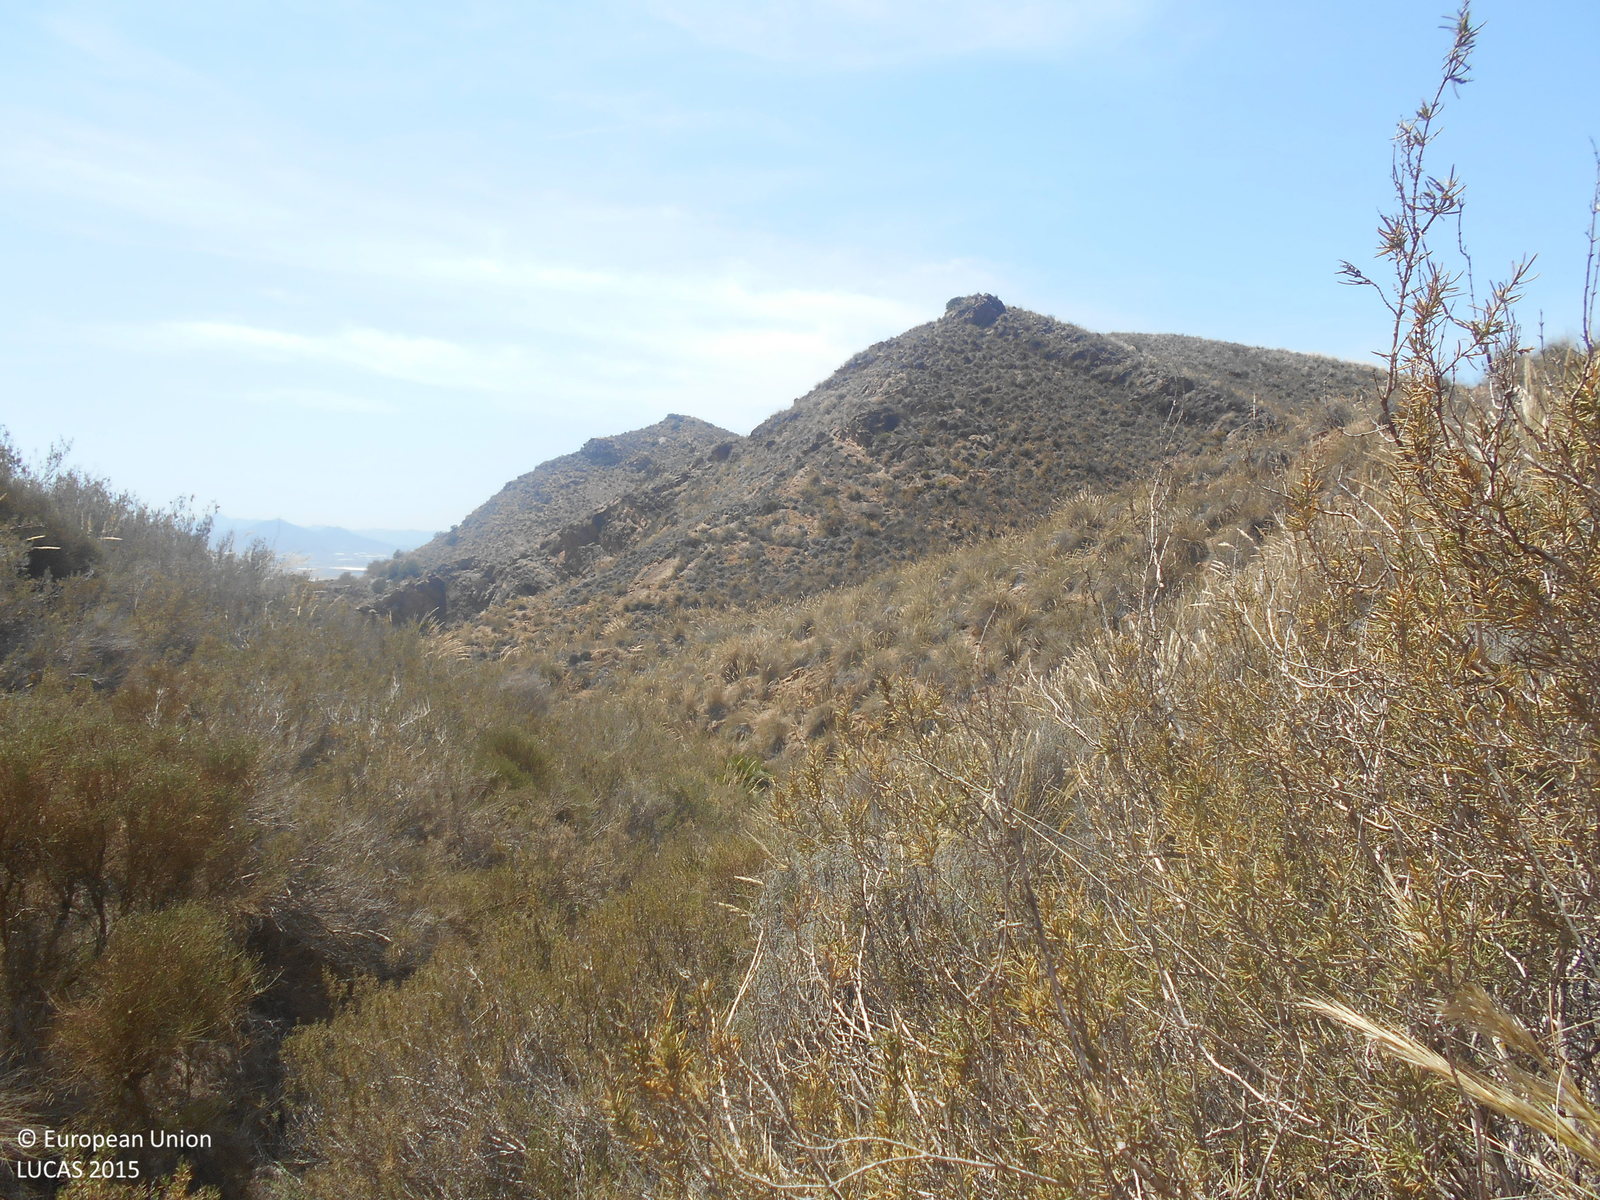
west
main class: Shrubland
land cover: Shrubland without tree cover
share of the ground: > 75 %
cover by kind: shrubs 90 %, unconsolidated bare surface 10 %
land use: Semi-natural and natural areas not in use
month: May
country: ES
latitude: 37.6387
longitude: -1.3014
